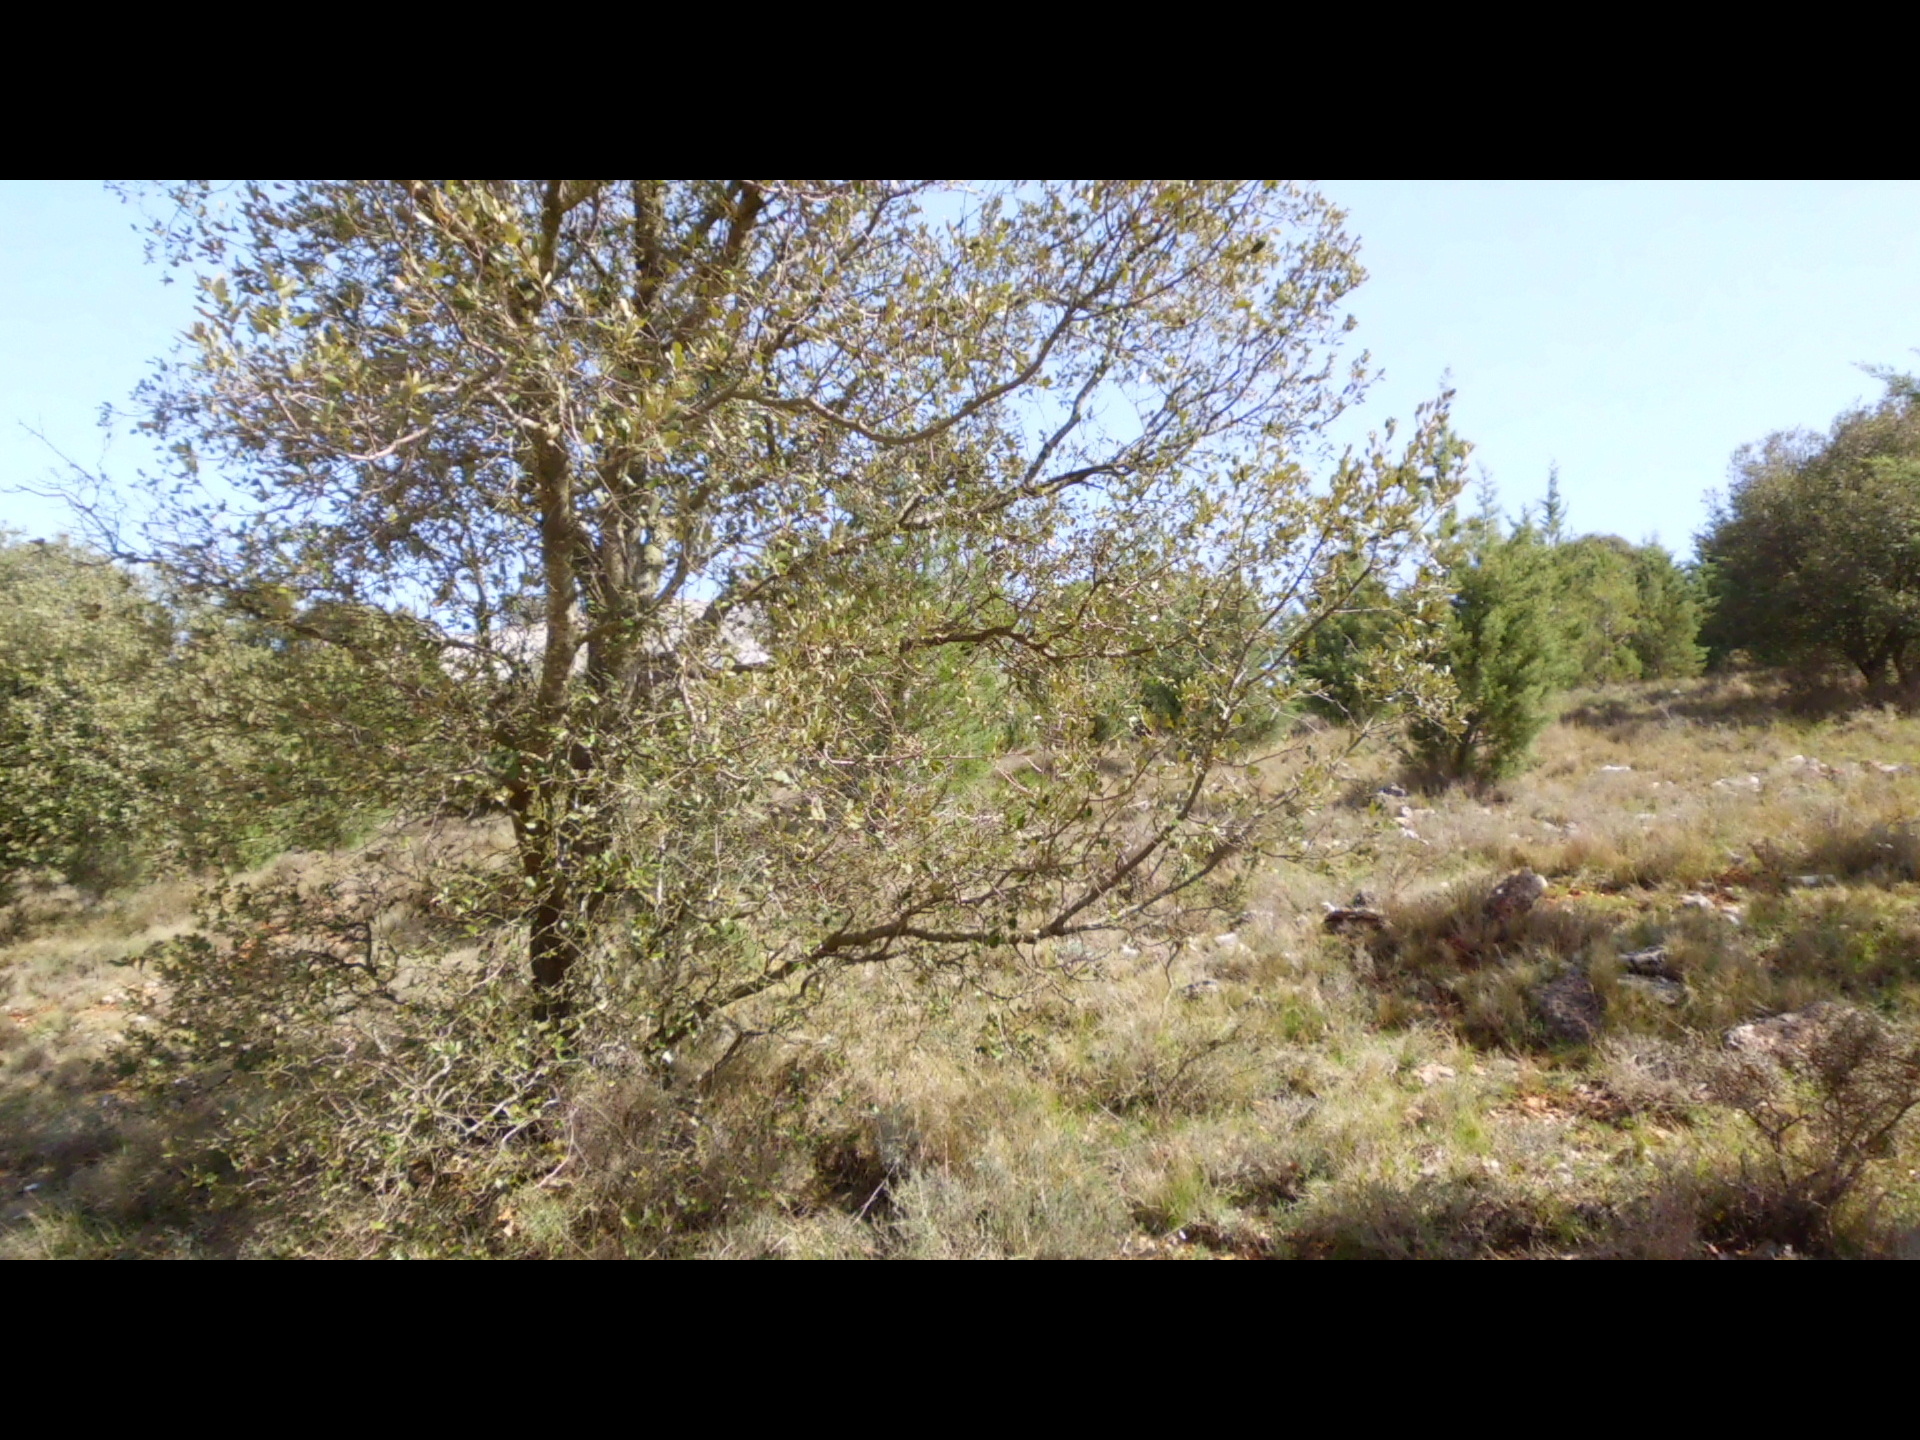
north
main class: Shrubland
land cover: Shrubland with sparse tree cover
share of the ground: > 75 %
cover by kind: herbaceous plants 60 %, shrubs 35 %, coniferous forest trees 5 %
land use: Agriculture (excluding fallow land and kitchen gardens)
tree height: < 5 m
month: April
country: ES
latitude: 42.5462
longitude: -3.3925
